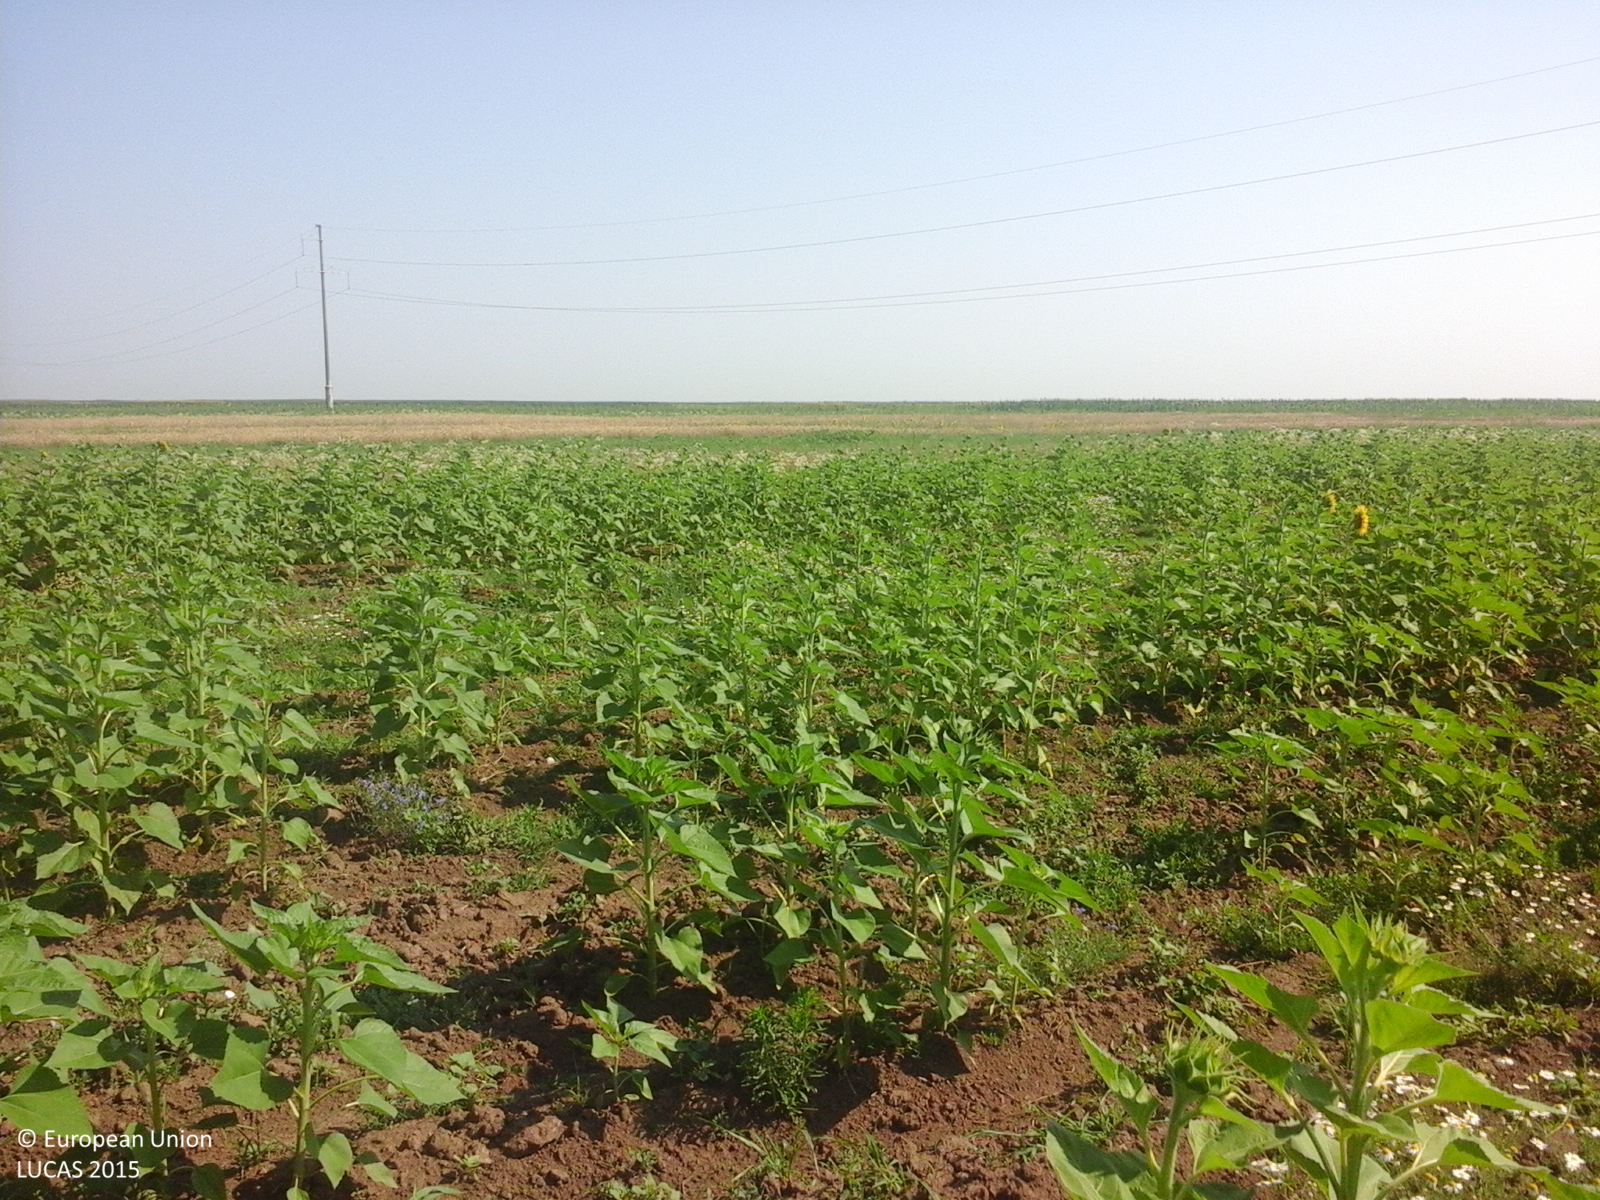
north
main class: Cropland
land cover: Sunflower
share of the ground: > 75 %
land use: Agriculture (excluding fallow land and kitchen gardens)
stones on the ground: < 10 %
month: July
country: RO
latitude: 44.1571
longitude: 25.3269
